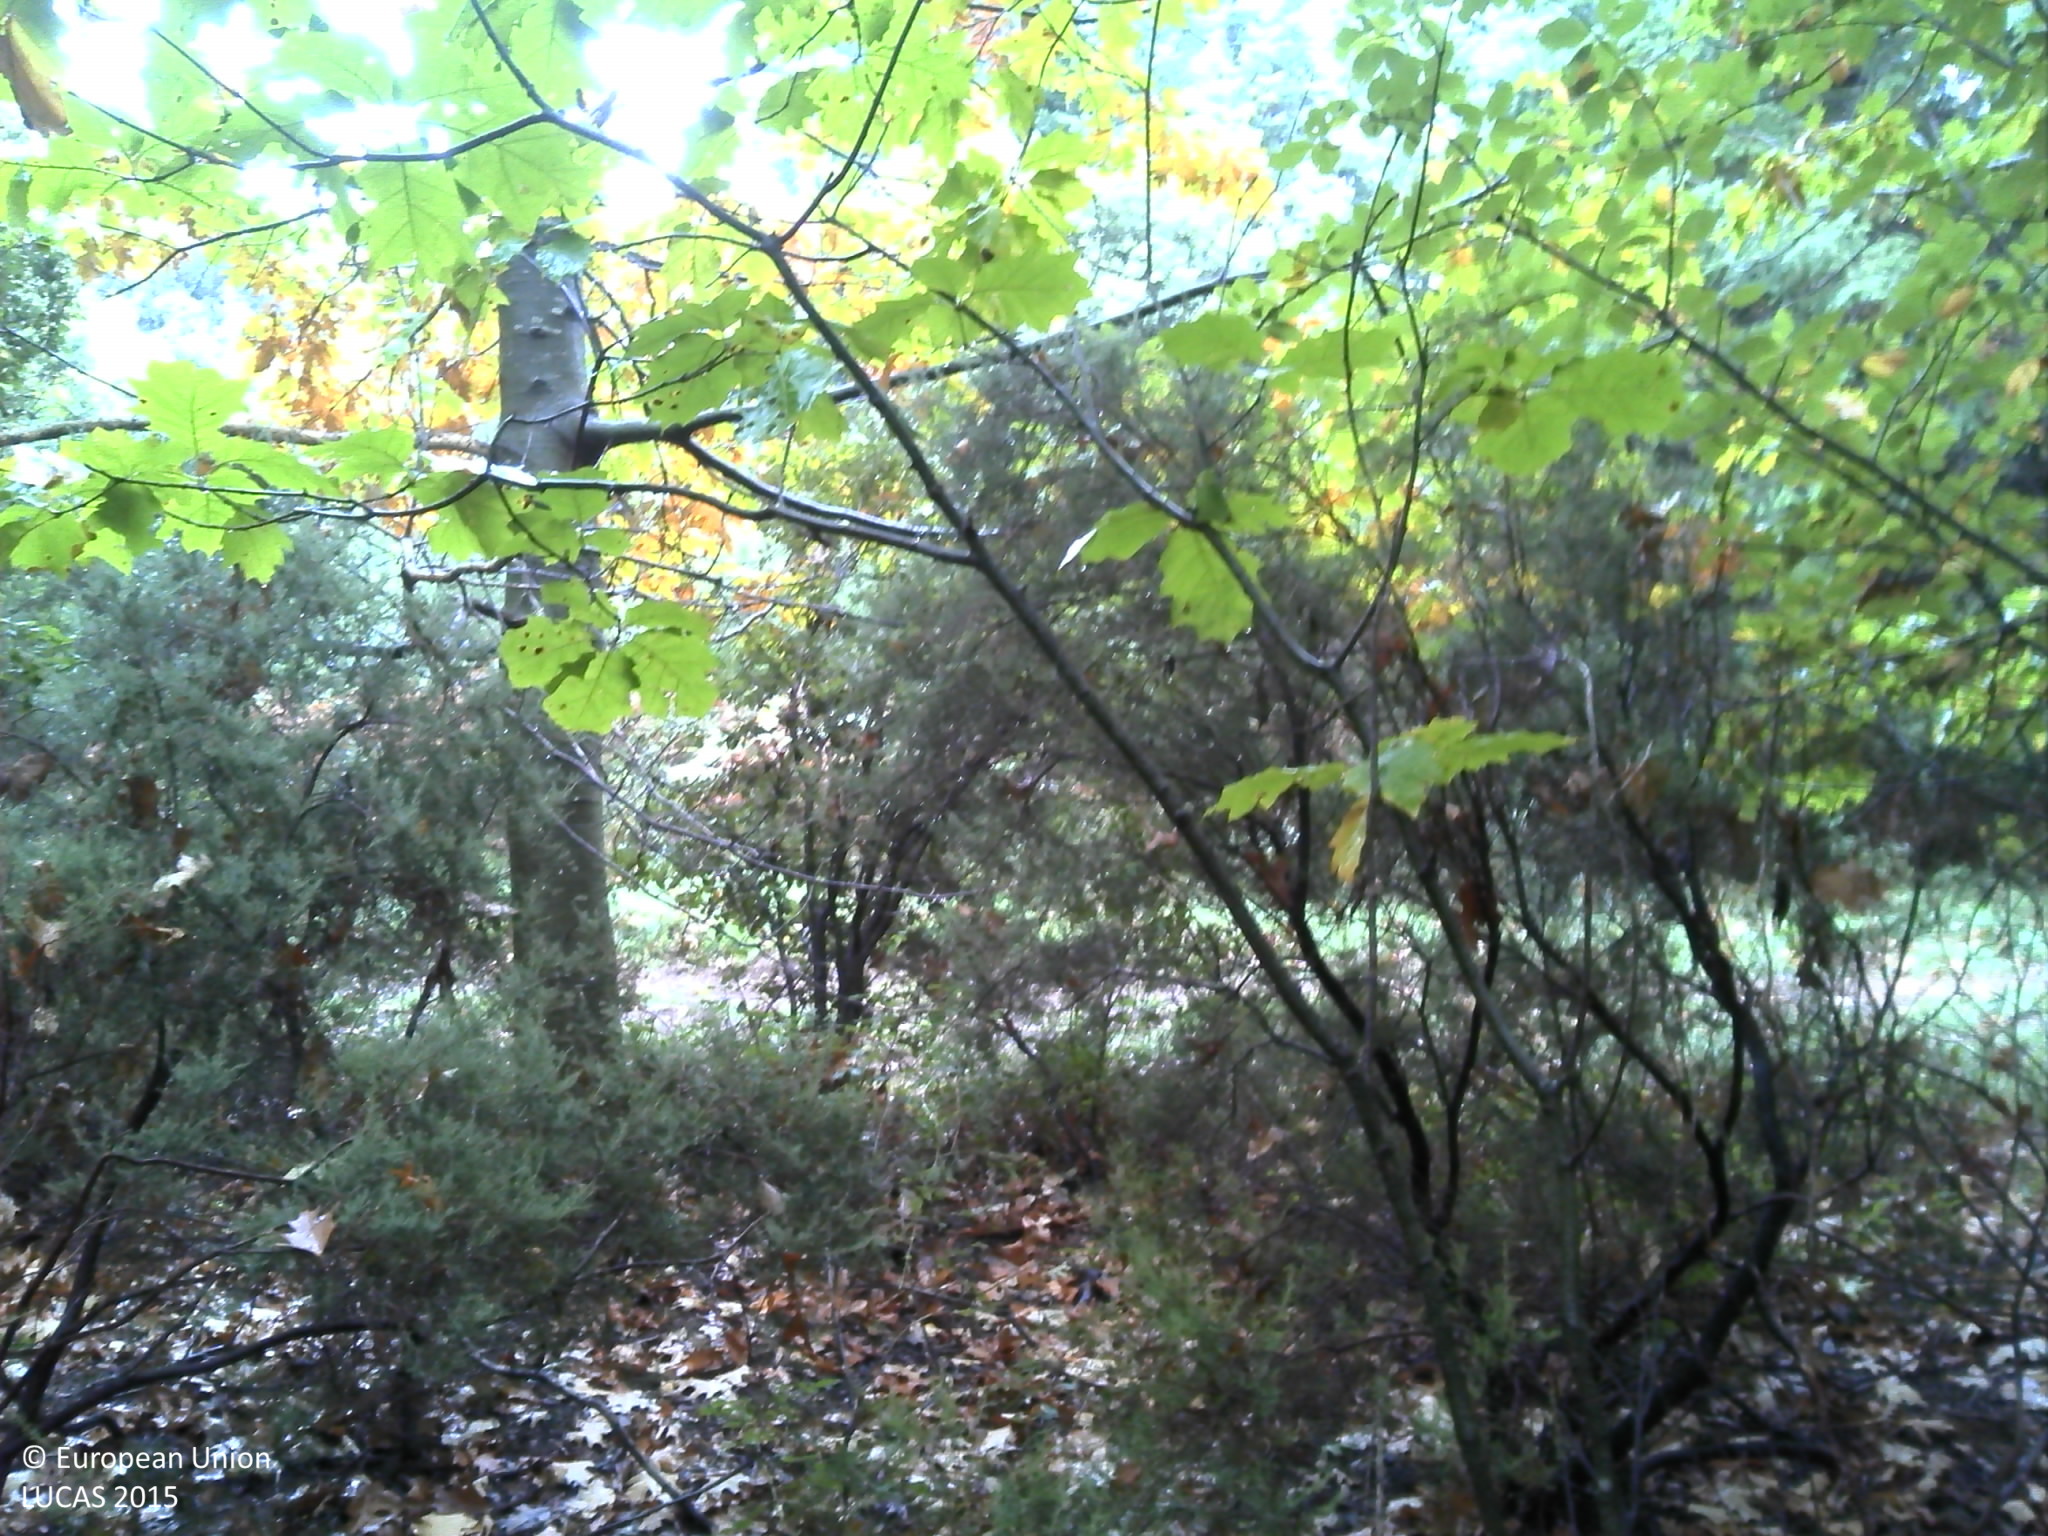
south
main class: Woodland
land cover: Pine dominated mixed woodland
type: mesophytic deciduous forest
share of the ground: > 75 %
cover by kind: coniferous forest trees 50 %, broadleaved forest trees 30 %, unconsolidated bare surface 20 %
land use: Forestry
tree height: > 5 m
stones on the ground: < 10 %
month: October
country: FR
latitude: 43.6110
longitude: 3.0570
